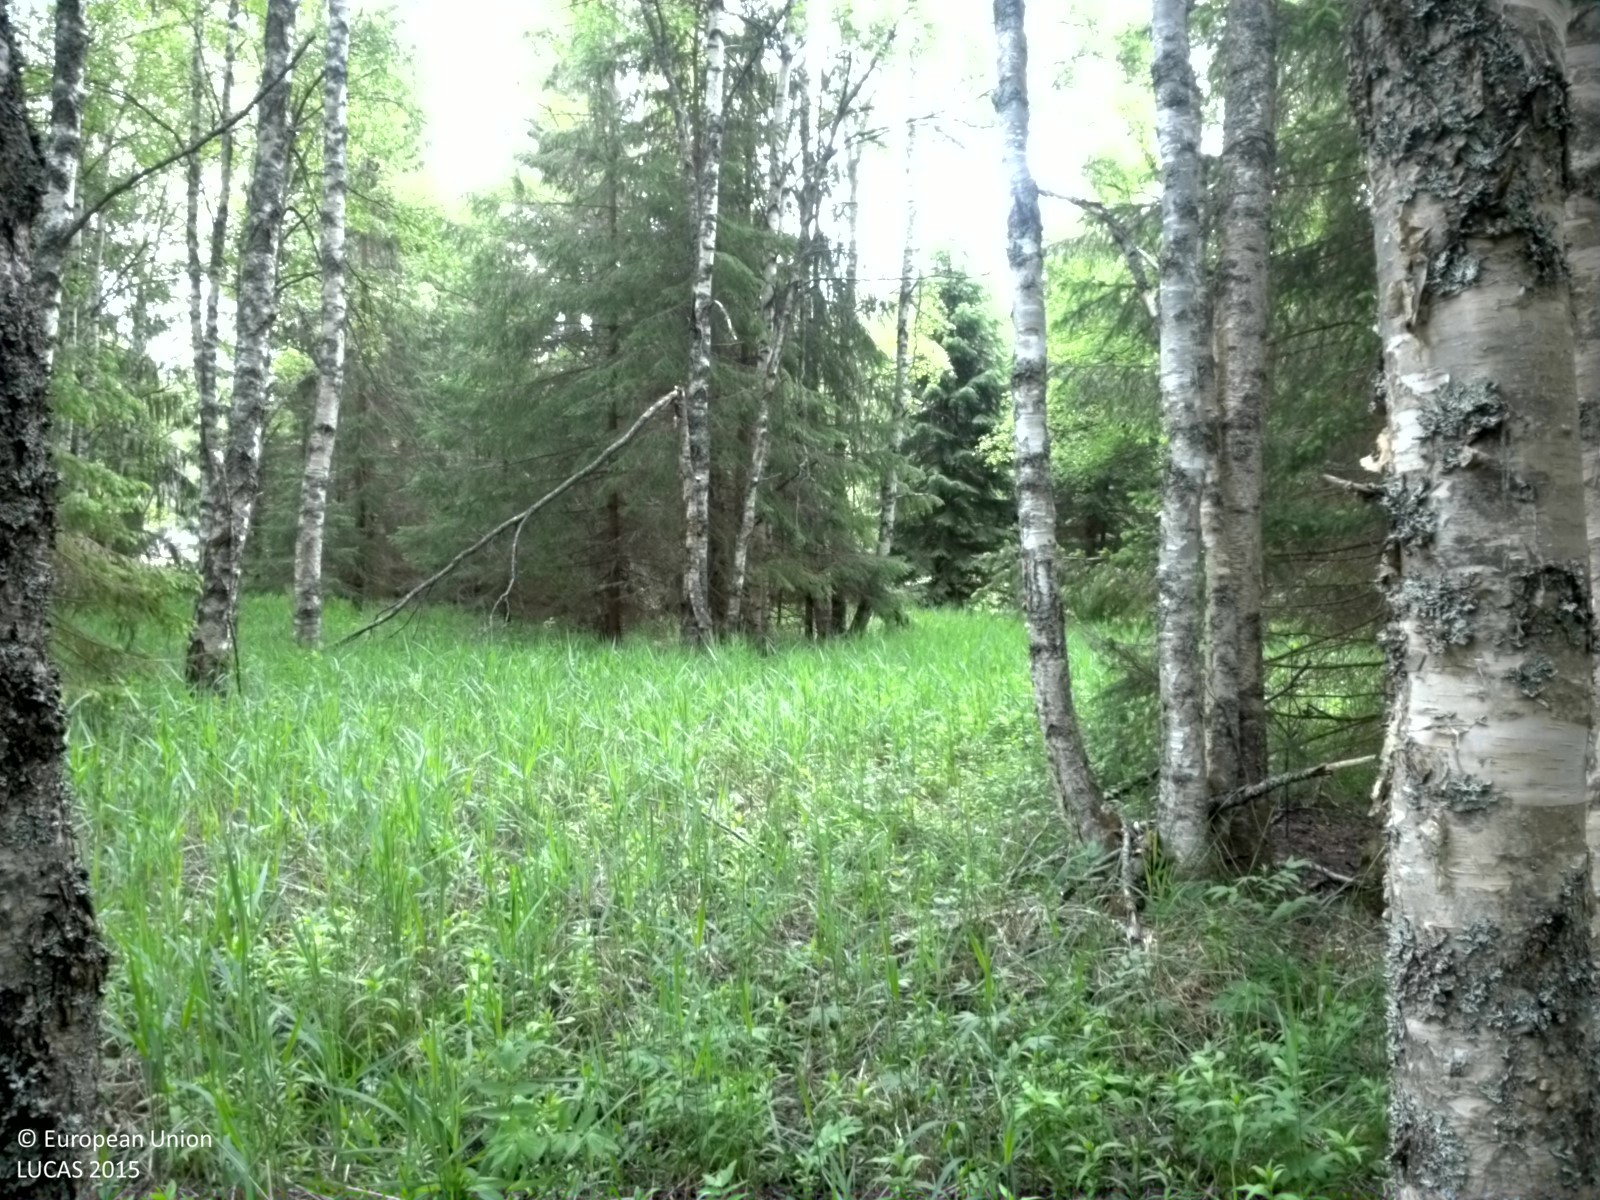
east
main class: Woodland
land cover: Spruce dominated mixed woodland
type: boreal forest
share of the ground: 50 - 75 %
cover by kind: herbaceous plants 45 %, broadleaved forest trees 35 %, coniferous forest trees 20 %
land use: Forestry
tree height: > 5 m
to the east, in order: Spruce dominated mixed woodland; Spruce dominated coniferous woodland; Inland marshes; Spruce dominated coniferous woodland; Spruce dominated mixed woodland; Grassland with sparse tree/shrub cover; Tracks; Broadleaved woodland
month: June
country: SE
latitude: 60.3485
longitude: 18.0576
